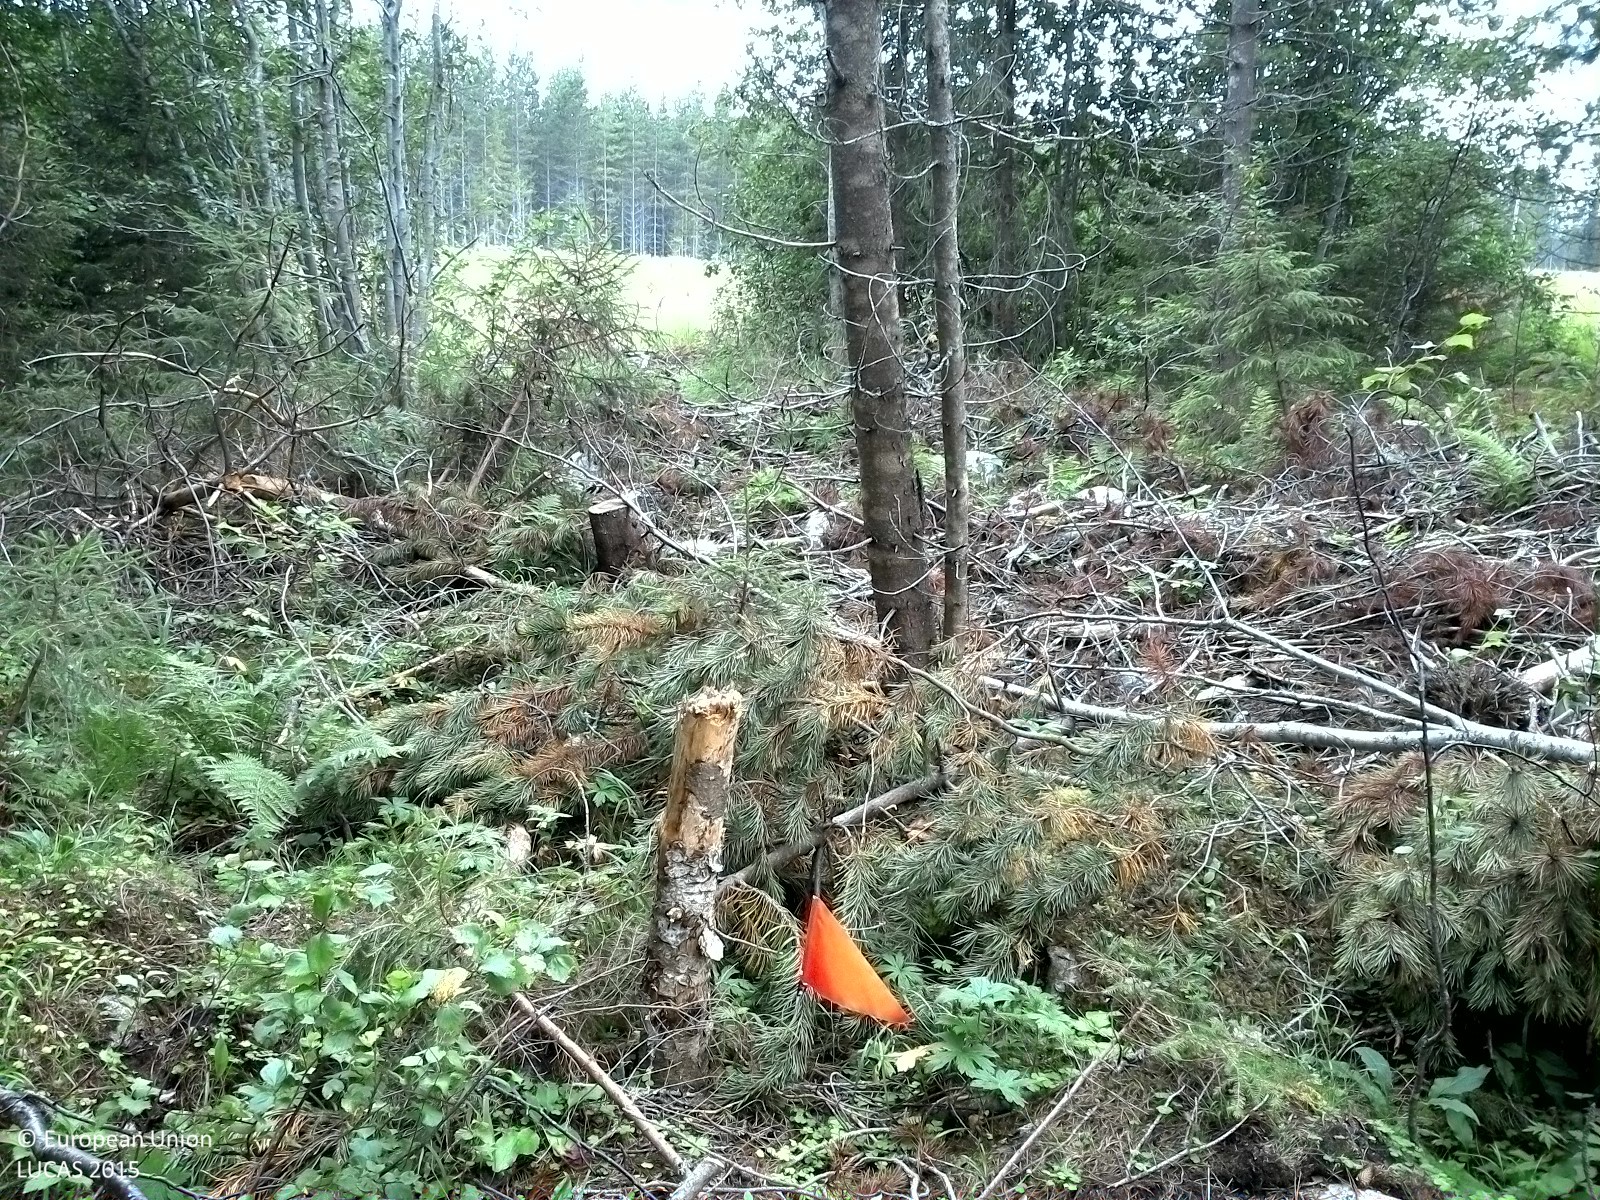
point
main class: Woodland
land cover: Pine dominated coniferous woodland
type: exotic forest
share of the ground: 50 - 75 %
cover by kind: coniferous forest trees 60 %, herbaceous plants 30 %, lichens and mosses 10 %
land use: Forestry
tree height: > 5 m
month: August
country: SE
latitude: 62.2105
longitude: 16.2677
